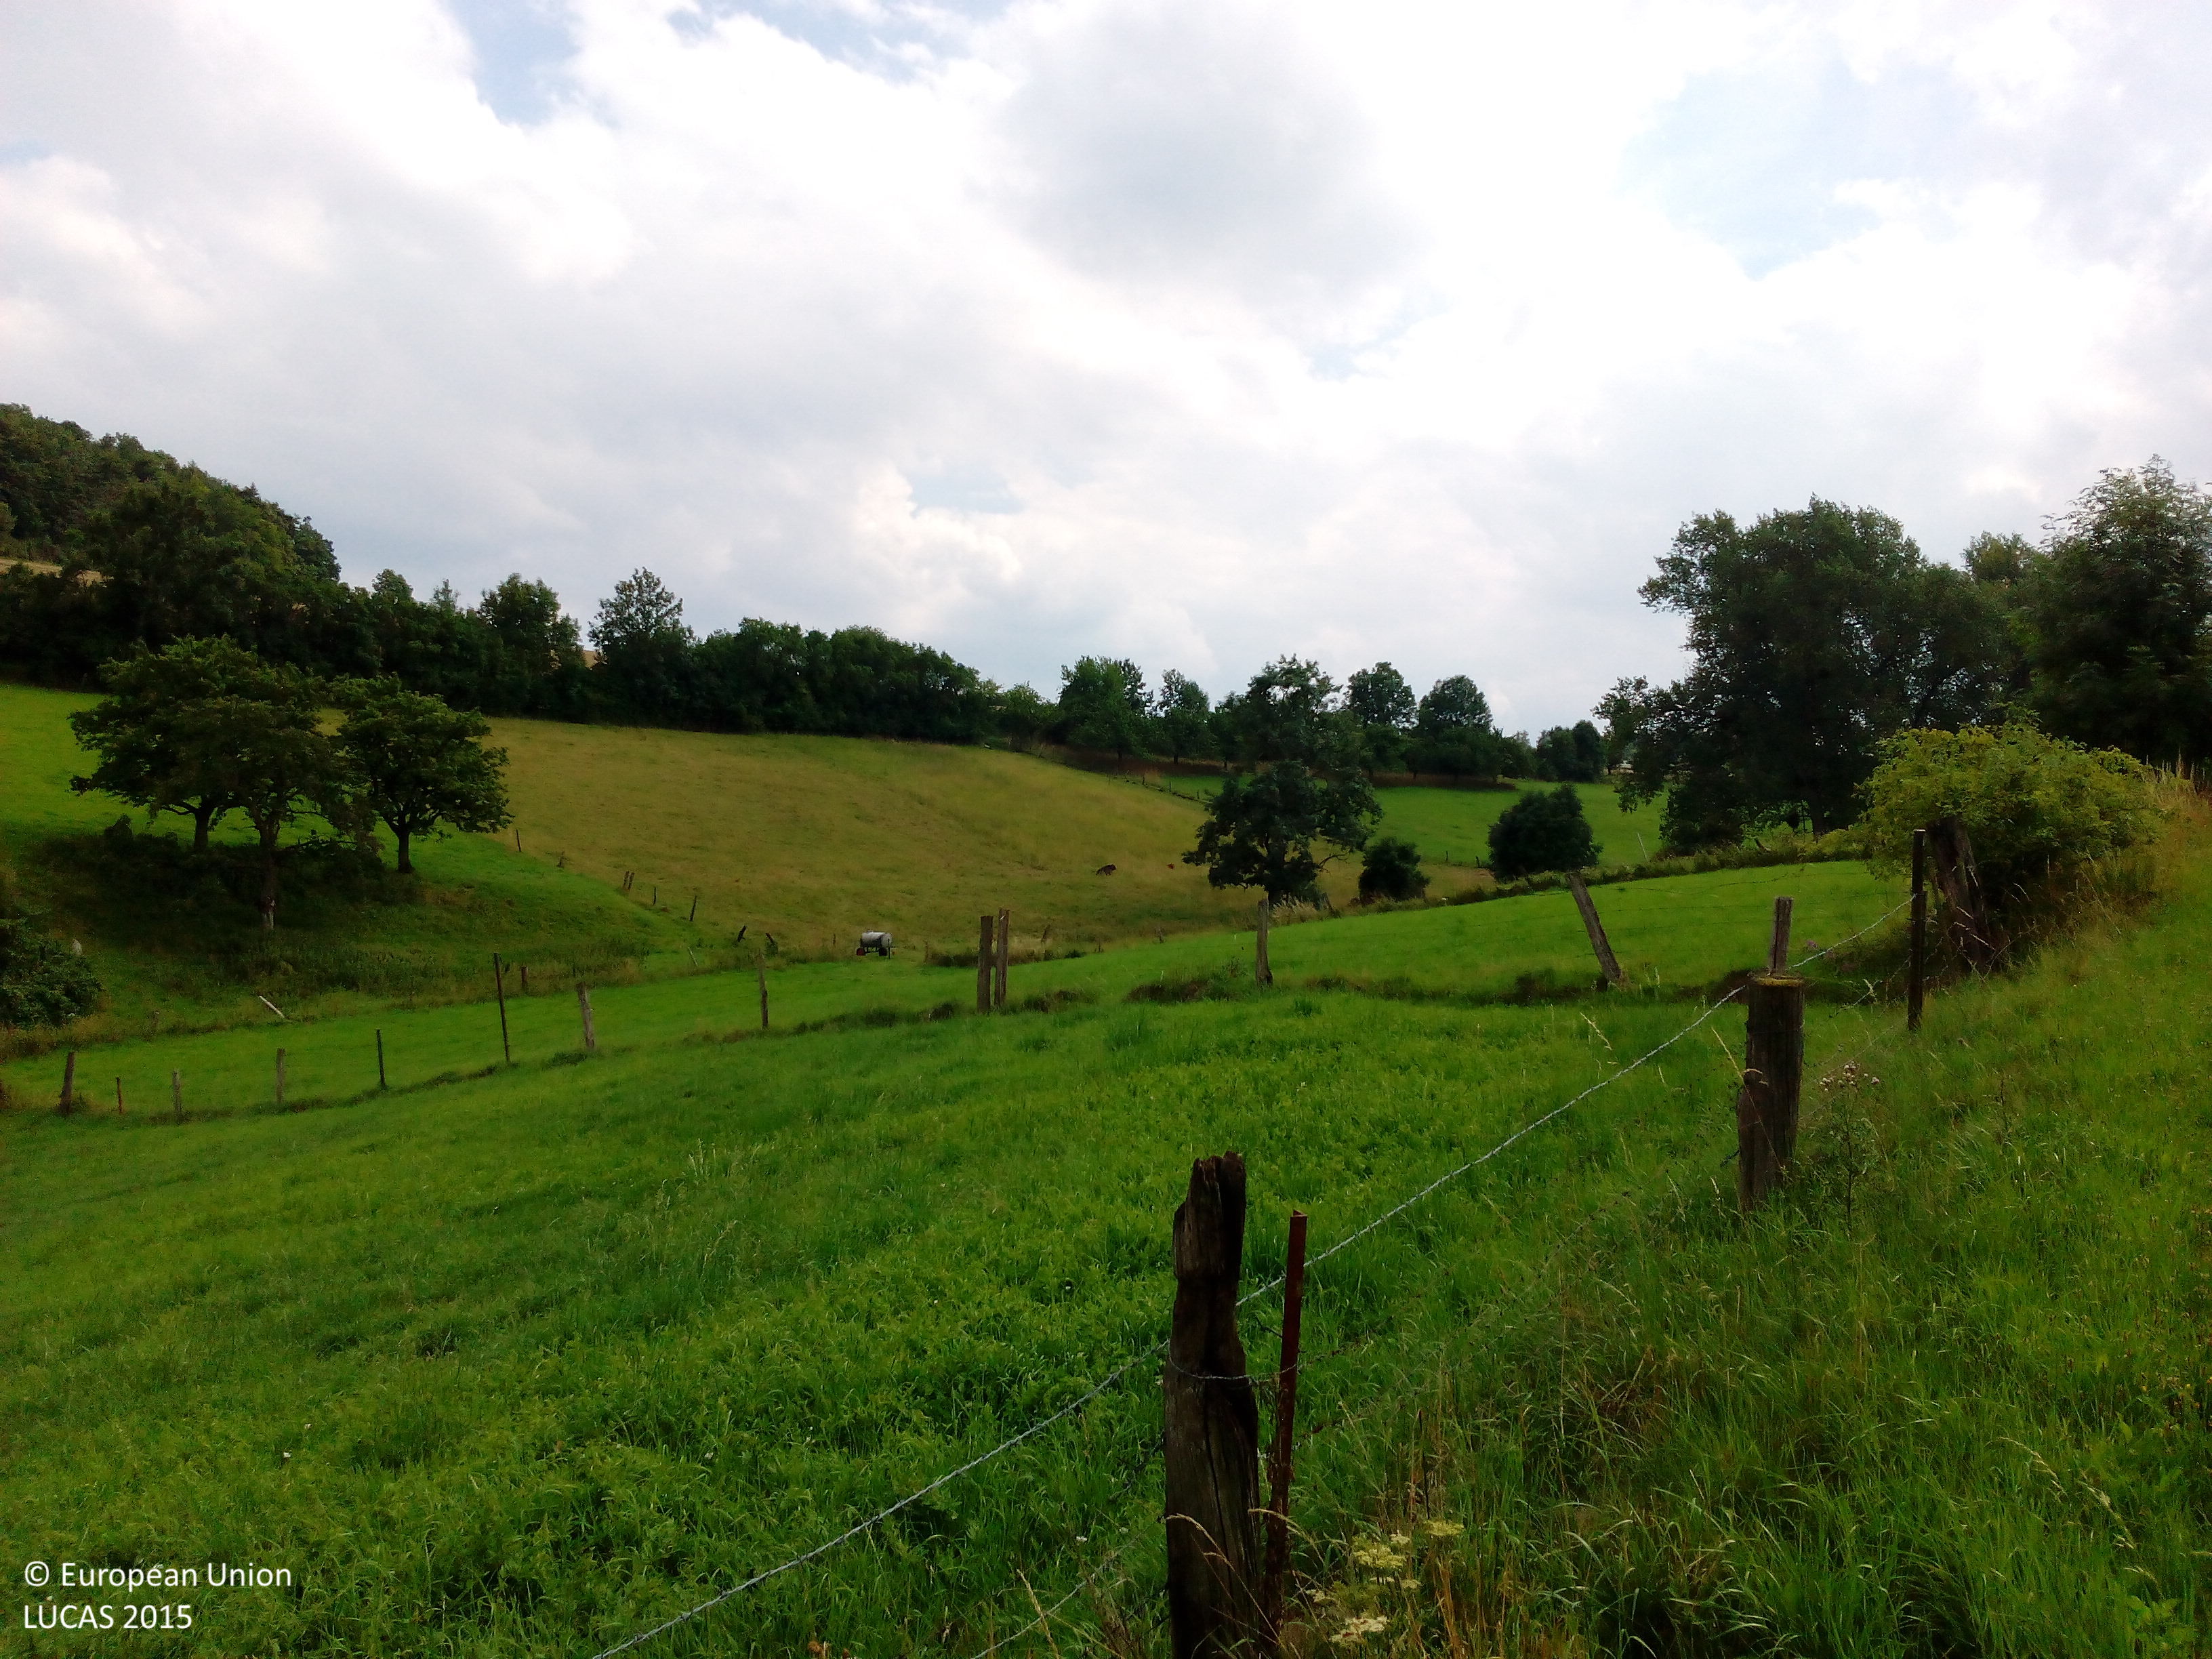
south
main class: Grassland
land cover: Grassland without tree/shrub cover
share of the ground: > 75 %
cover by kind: herbaceous plants 100 %
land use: Agriculture (excluding fallow land and kitchen gardens)
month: July
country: DE
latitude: 51.4247
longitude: 9.8706
